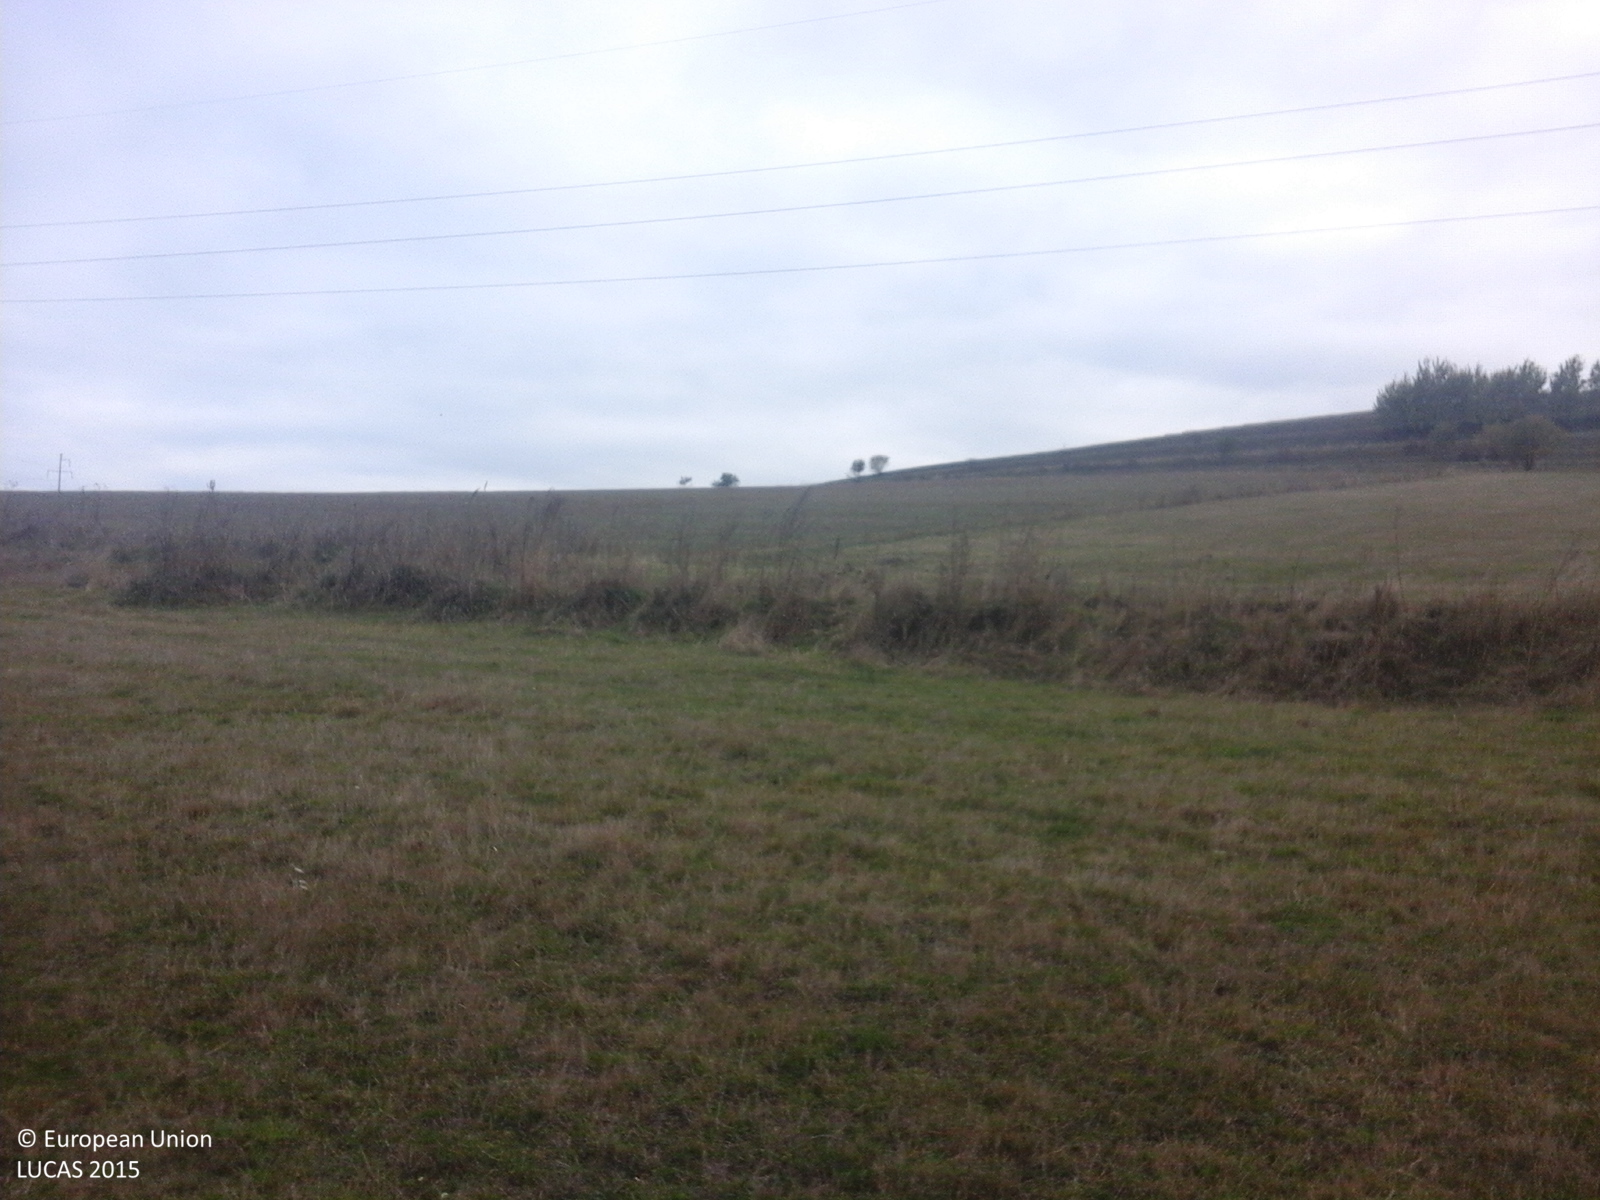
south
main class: Grassland
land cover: Grassland without tree/shrub cover
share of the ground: > 75 %
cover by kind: herbaceous plants 100 %
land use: Agriculture (excluding fallow land and kitchen gardens)
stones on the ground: < 10 %
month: October
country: RO
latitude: 46.3379
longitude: 25.8223
